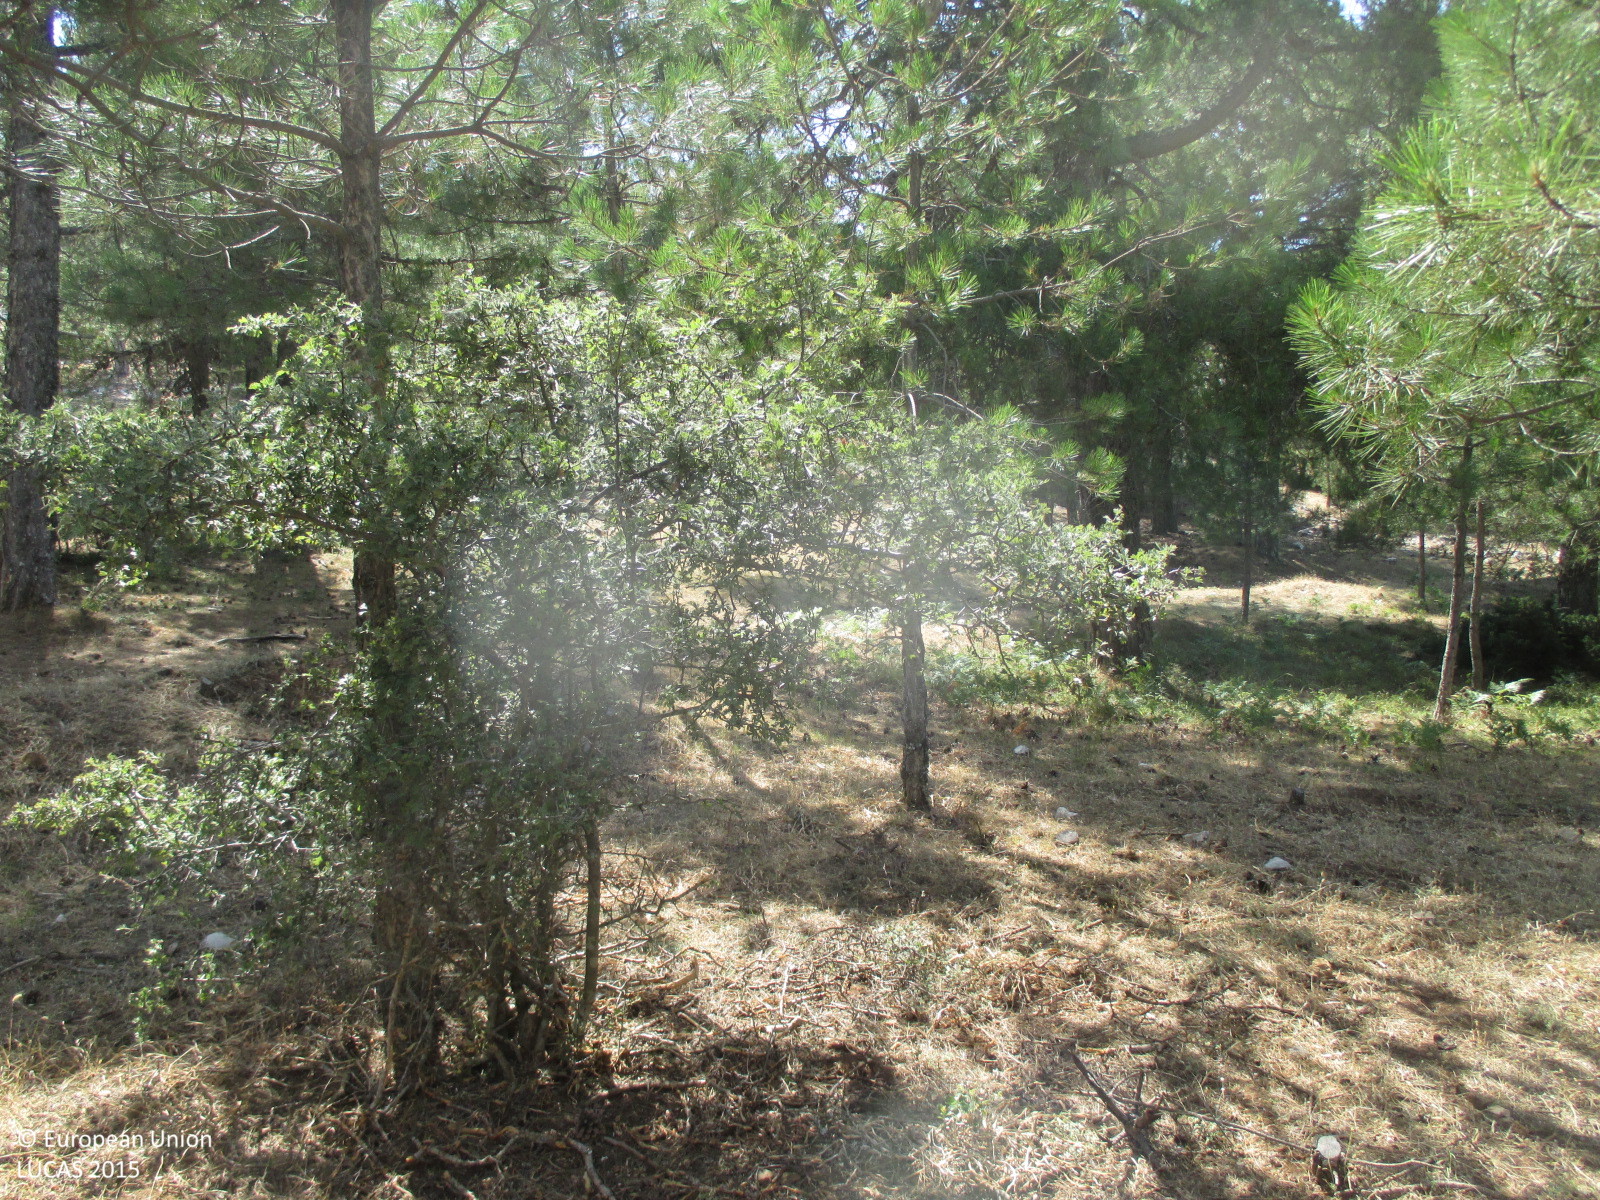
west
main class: Woodland
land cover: Pine dominated coniferous woodland
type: coniferous forest of the mediterranean region
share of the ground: > 75 %
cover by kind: coniferous forest trees 90 %, lichens and mosses 10 %
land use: Forestry
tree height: > 5 m
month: July
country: ES
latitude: 38.3419
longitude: -2.5485
